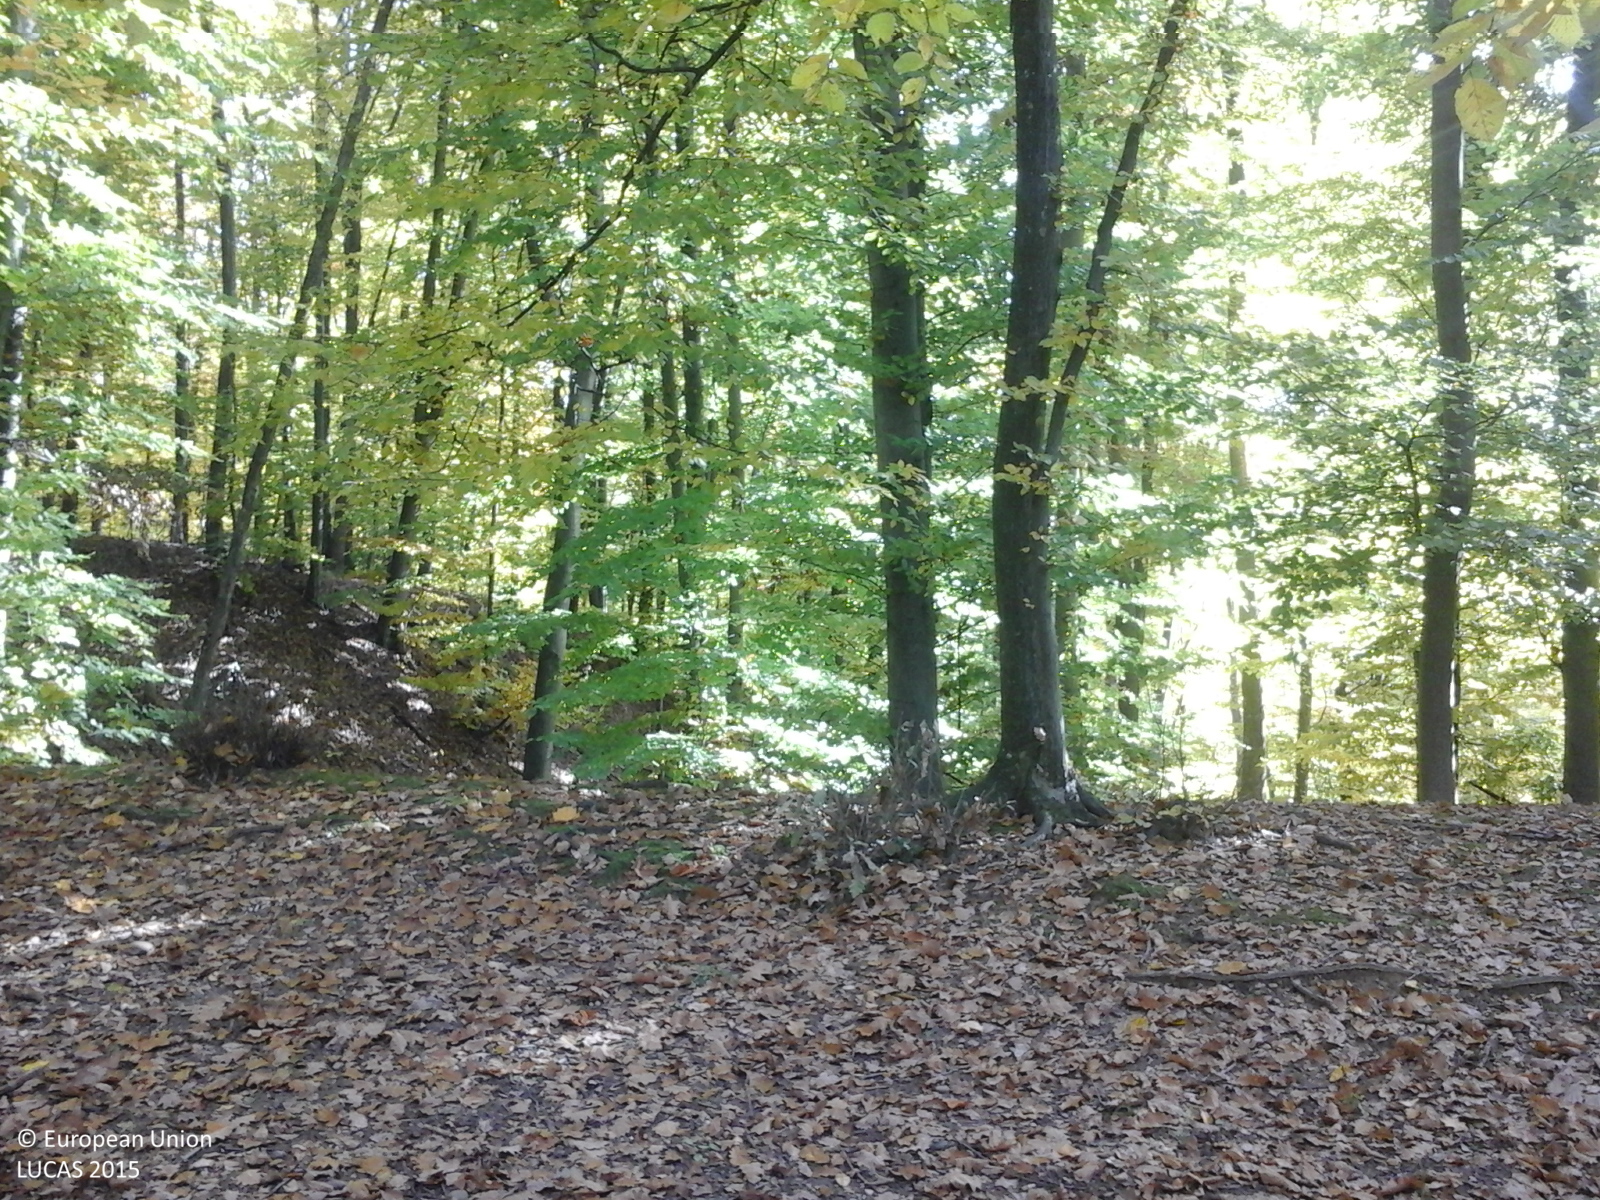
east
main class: Woodland
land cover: Broadleaved woodland
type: beech forest
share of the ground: > 75 %
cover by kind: broadleaved forest trees 100 %
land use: Forestry
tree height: > 5 m
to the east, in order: Broadleaved woodland; Tracks; Broadleaved woodland
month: October
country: RO
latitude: 46.0027
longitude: 26.9154
